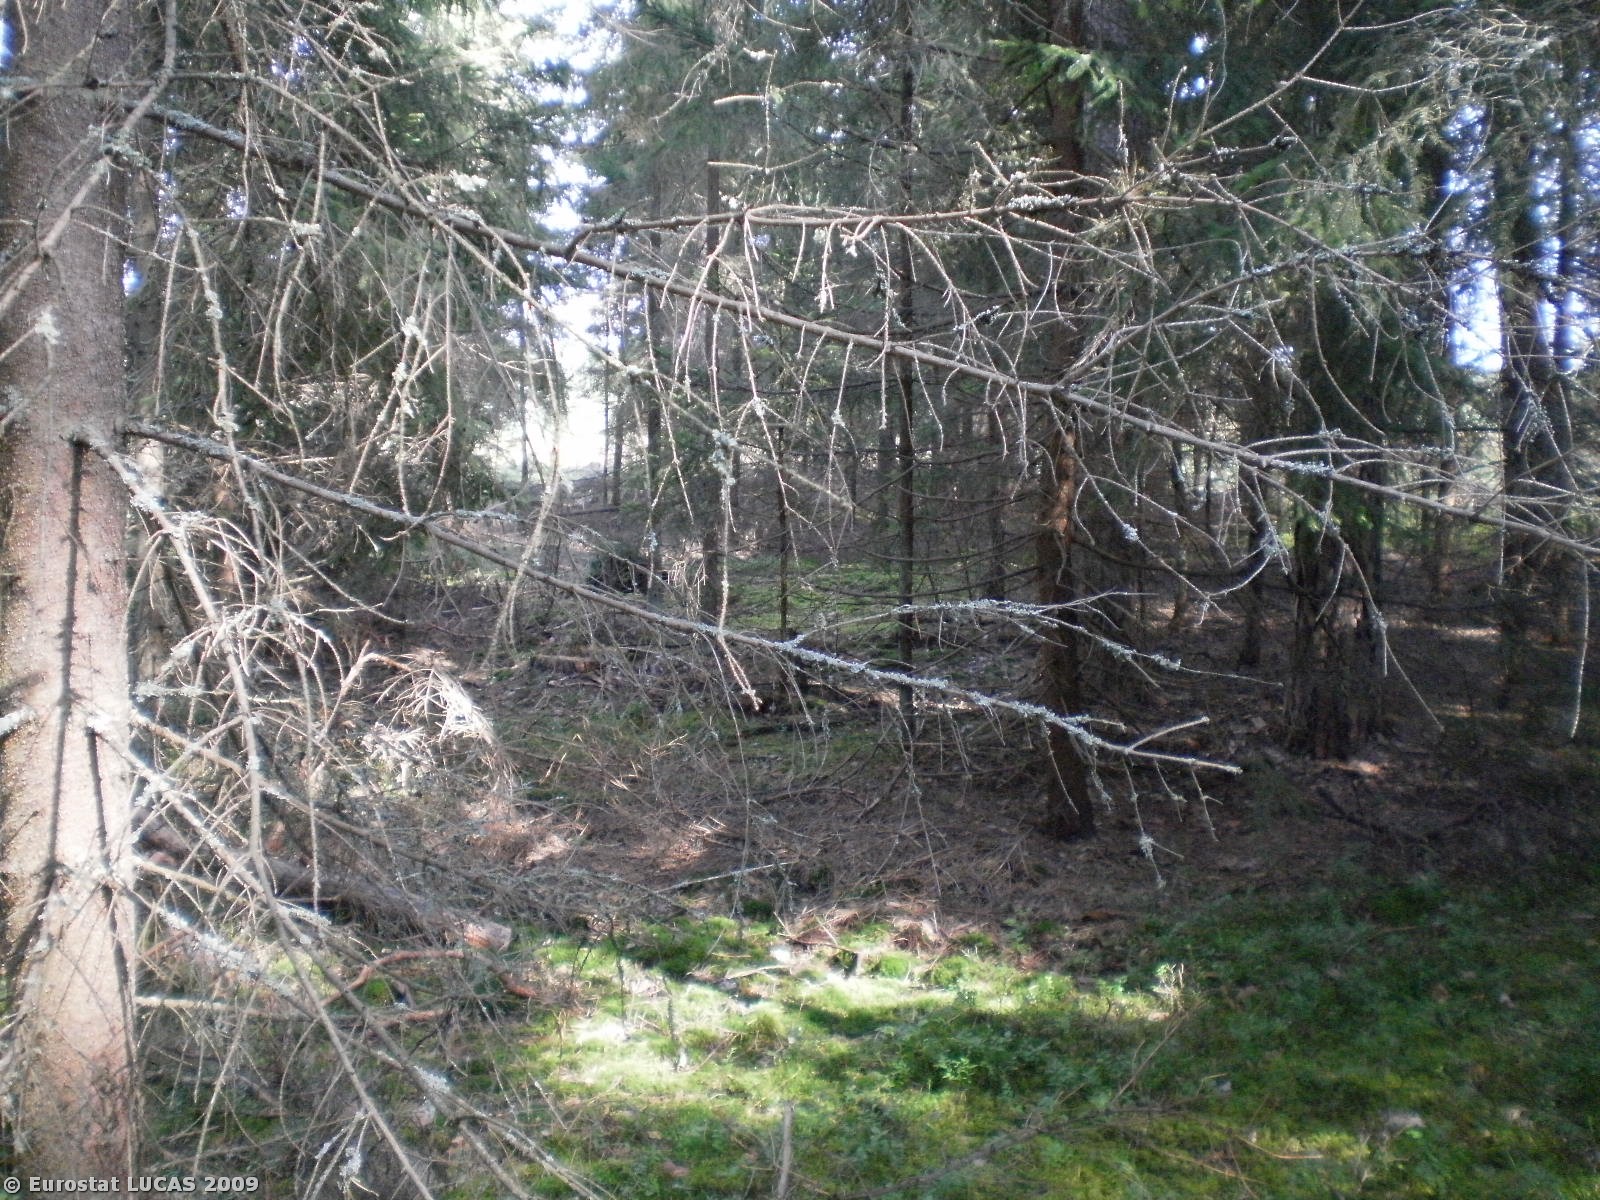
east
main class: Woodland
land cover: Coniferous woodland
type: hemiboreal forest and nemoral coniferous forest and mixed broadleaved-coniferous forest
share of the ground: 50 - 75 %
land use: Forestry
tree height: > 5 m
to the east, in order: Coniferous woodland; Mixed woodland; Coniferous woodland
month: August
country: PL
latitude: 52.7730
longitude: 21.7496
